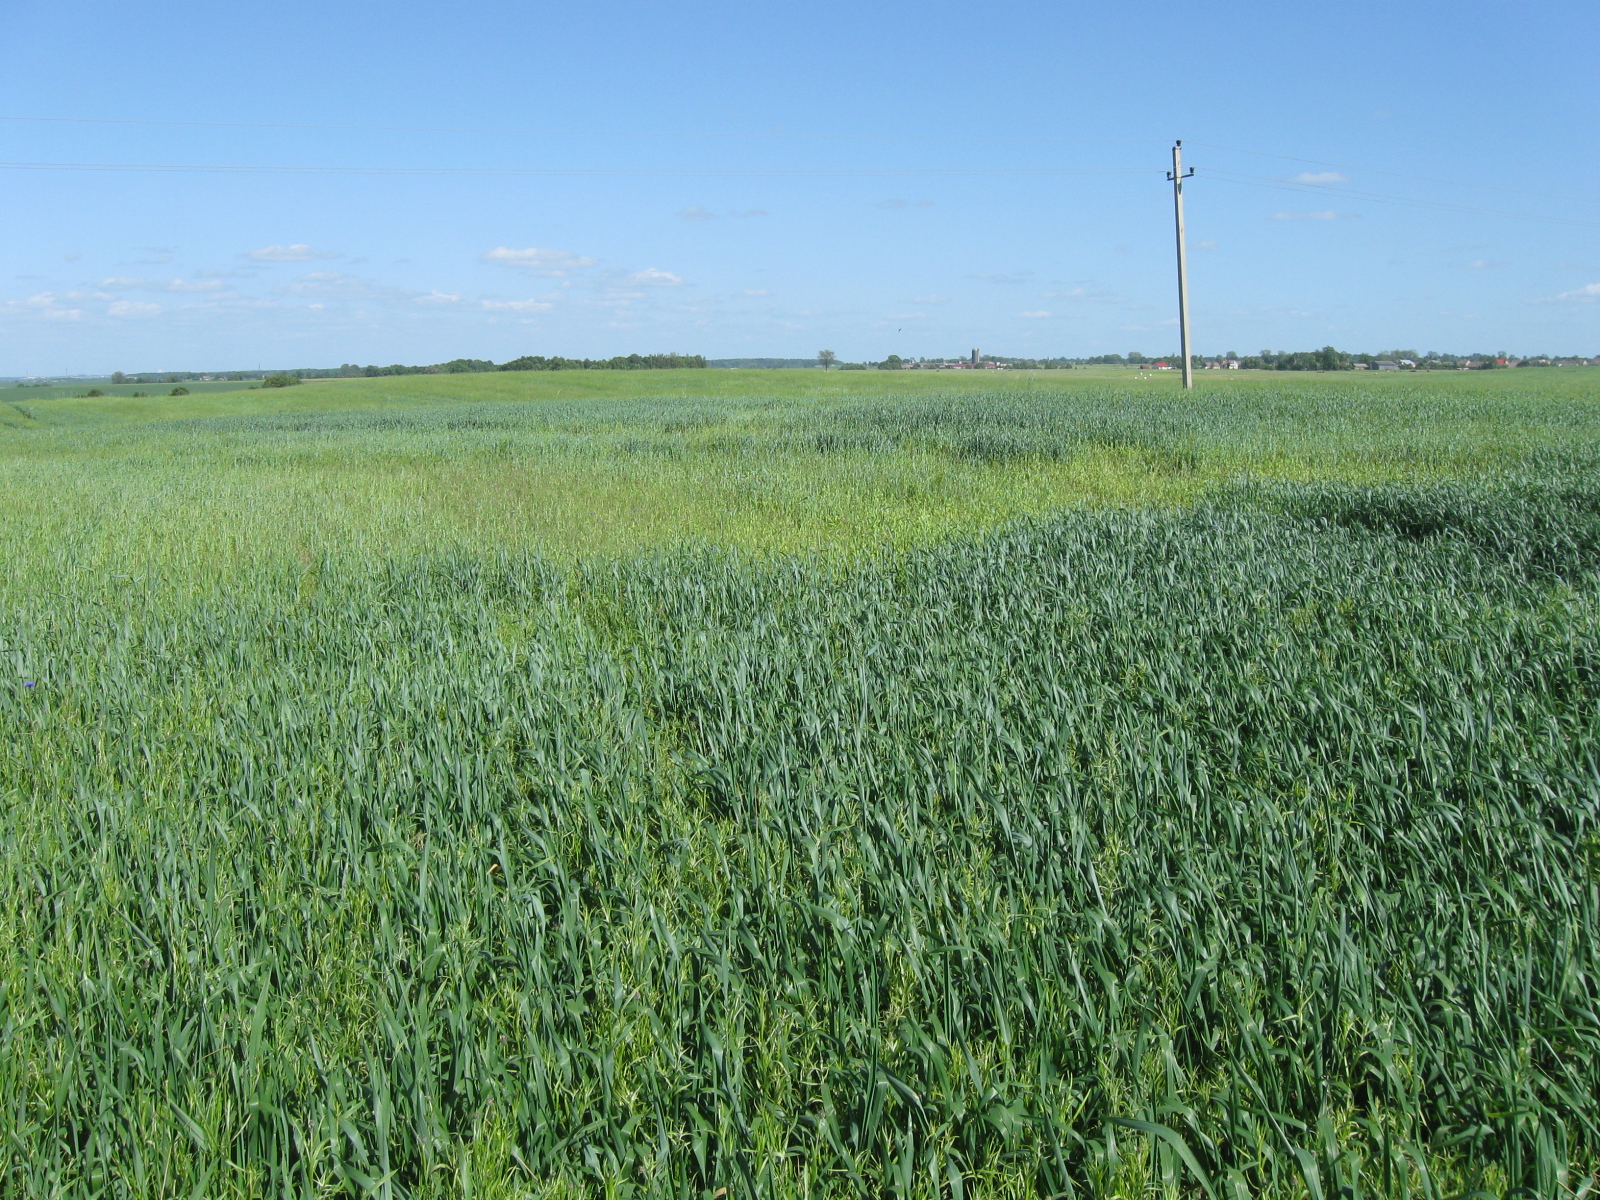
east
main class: Cropland
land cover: Common wheat
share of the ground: > 75 %
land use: Agriculture (excluding fallow land and kitchen gardens)
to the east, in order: Common wheat; Electric lines; Common wheat
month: June
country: LT
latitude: 54.3981
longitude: 23.7811
